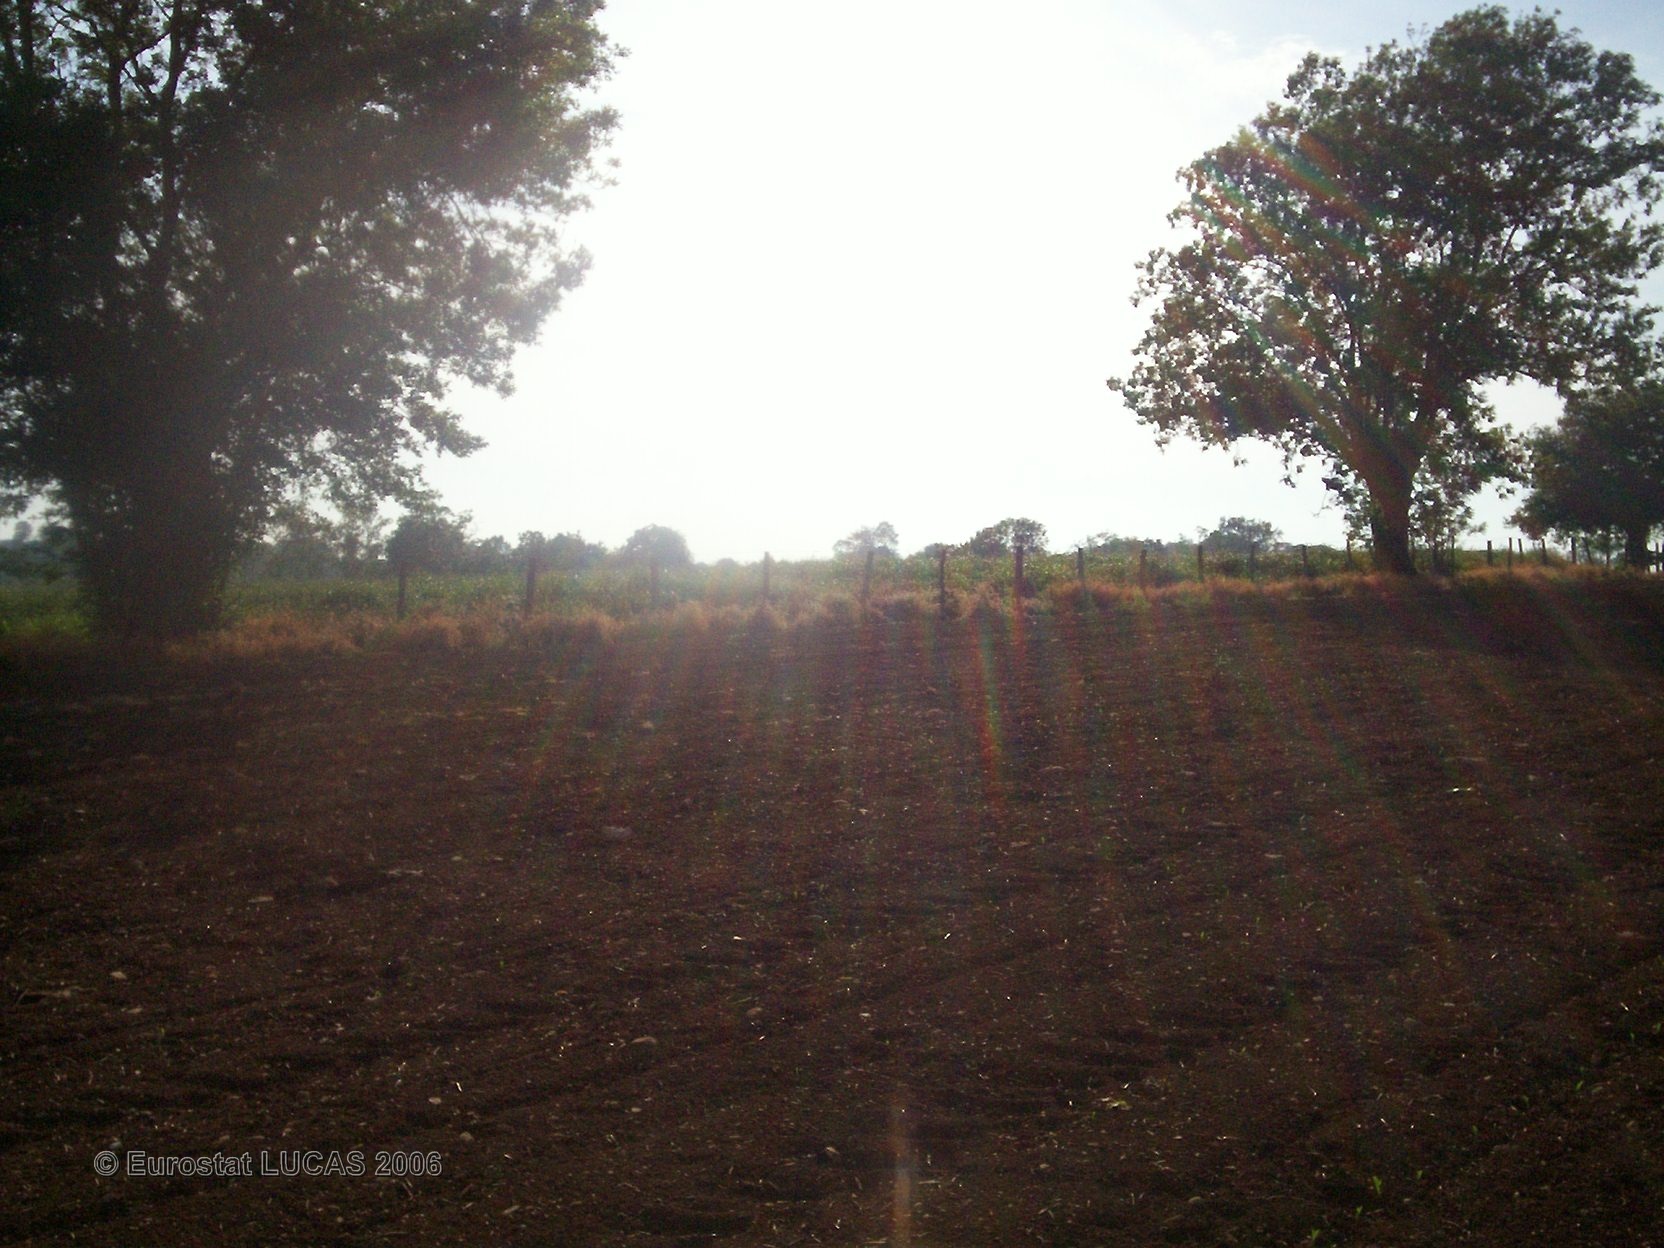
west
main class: Cropland
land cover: Maize
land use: Agriculture (excluding fallow land and kitchen gardens)
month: May
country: FR
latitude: 46.4342
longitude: -0.2927
